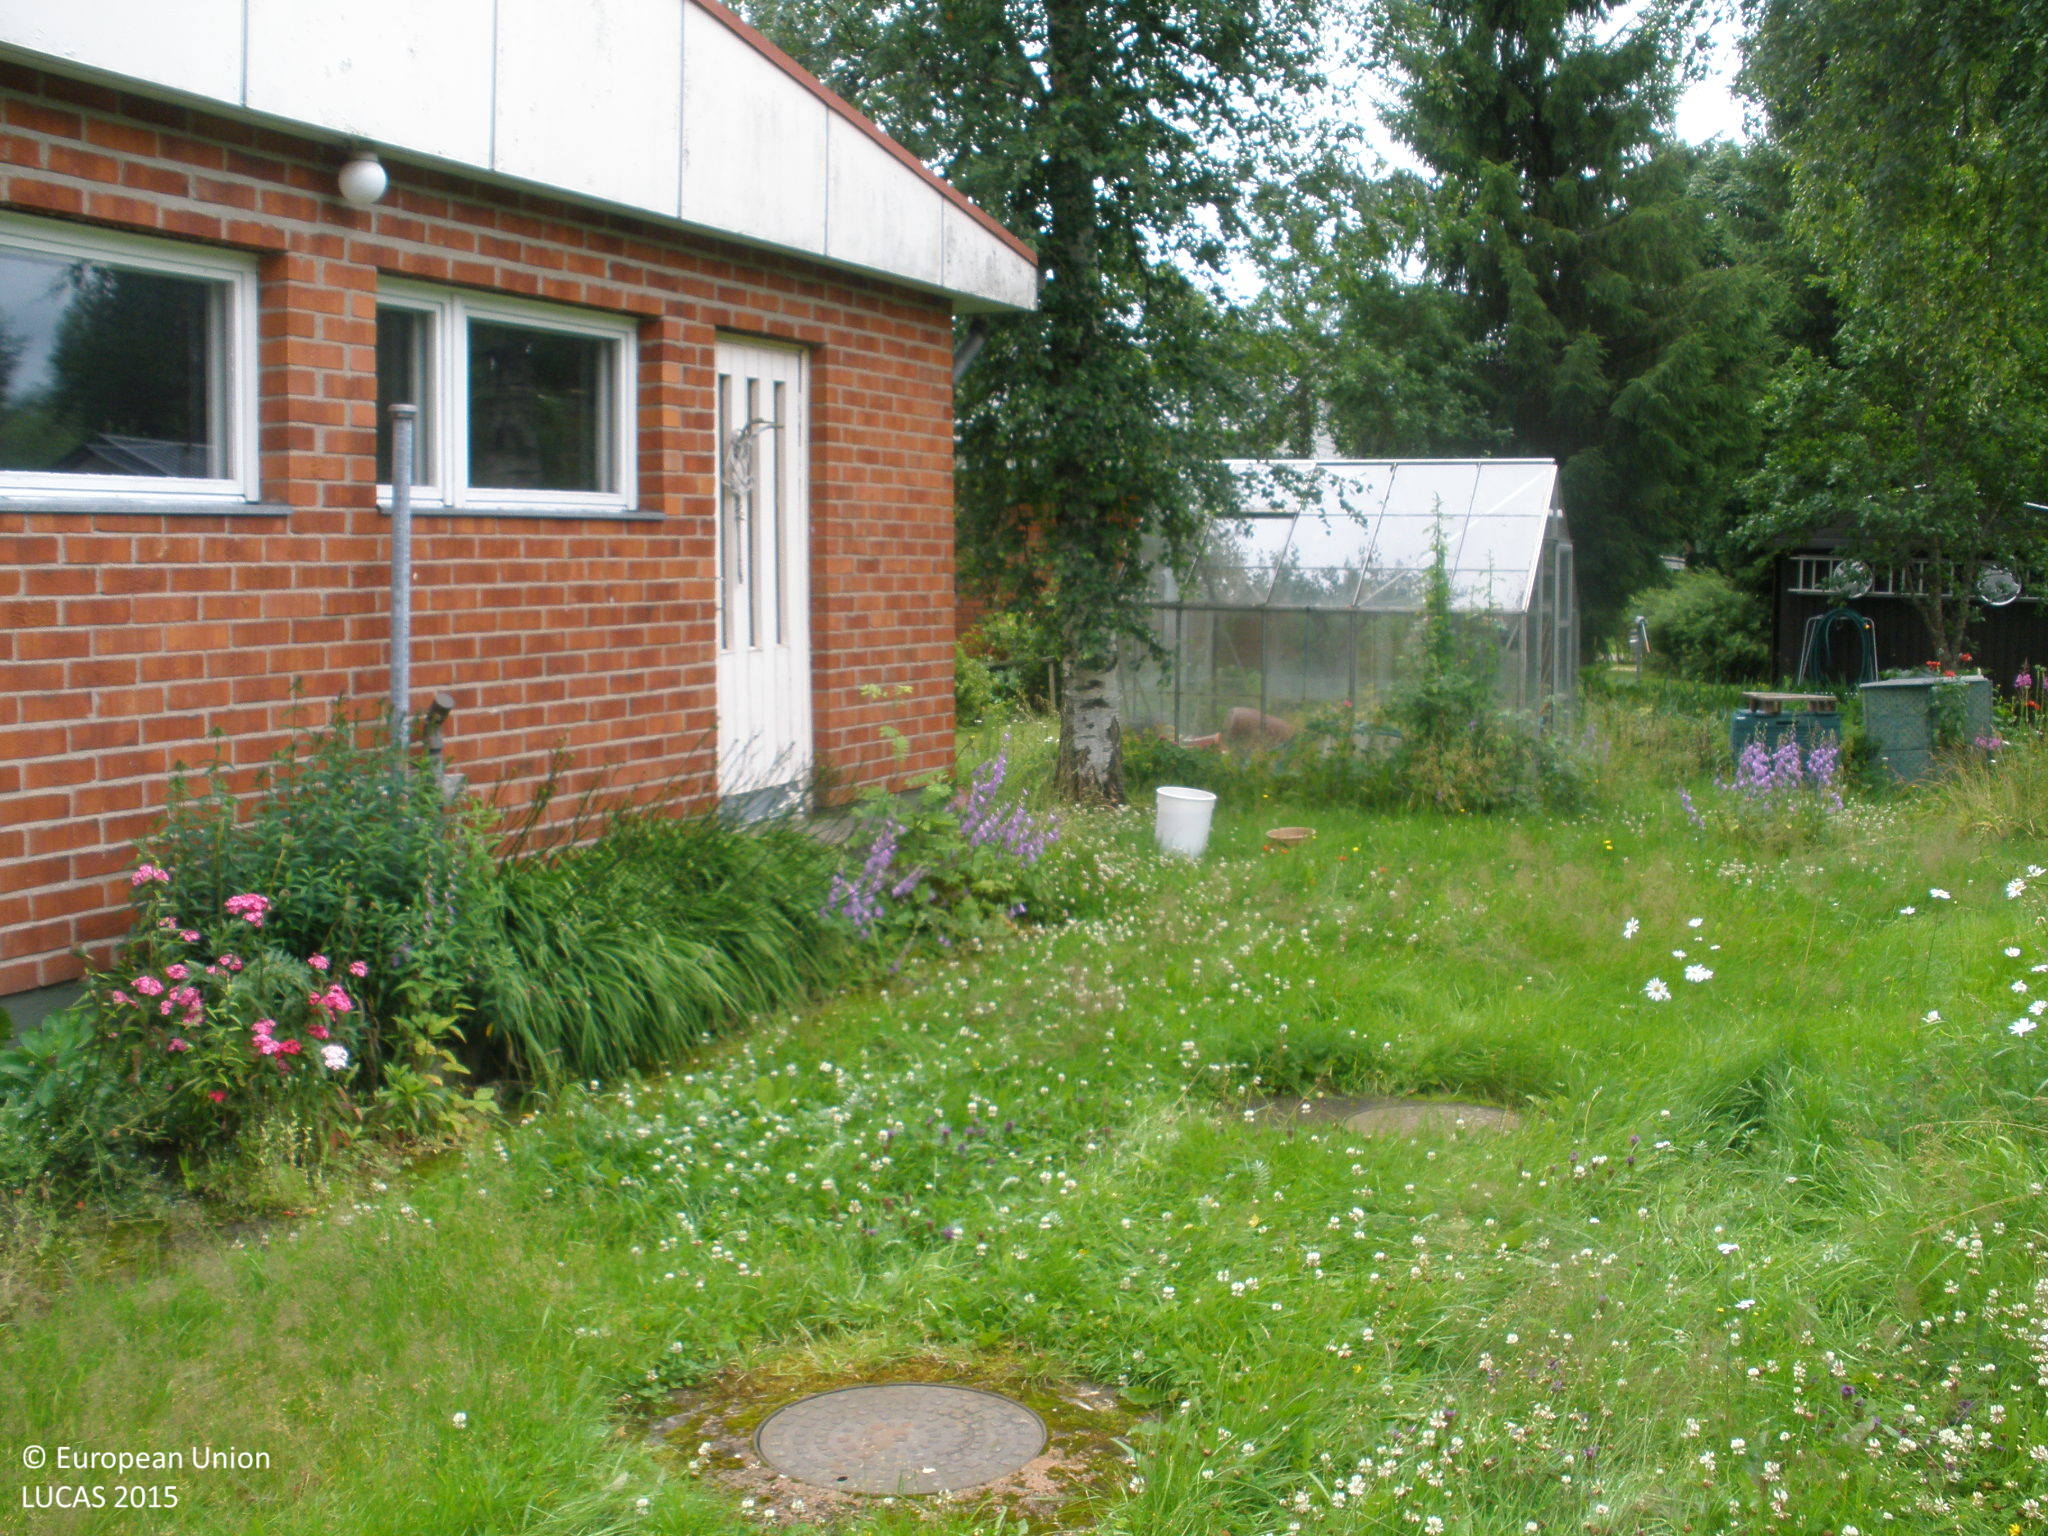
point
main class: Grassland
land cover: Grassland with sparse tree/shrub cover
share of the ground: > 75 %
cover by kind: herbaceous plants 95 %, broadleaved forest trees 5 %
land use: Residential
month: July
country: FI
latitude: 60.6243
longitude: 23.5187
